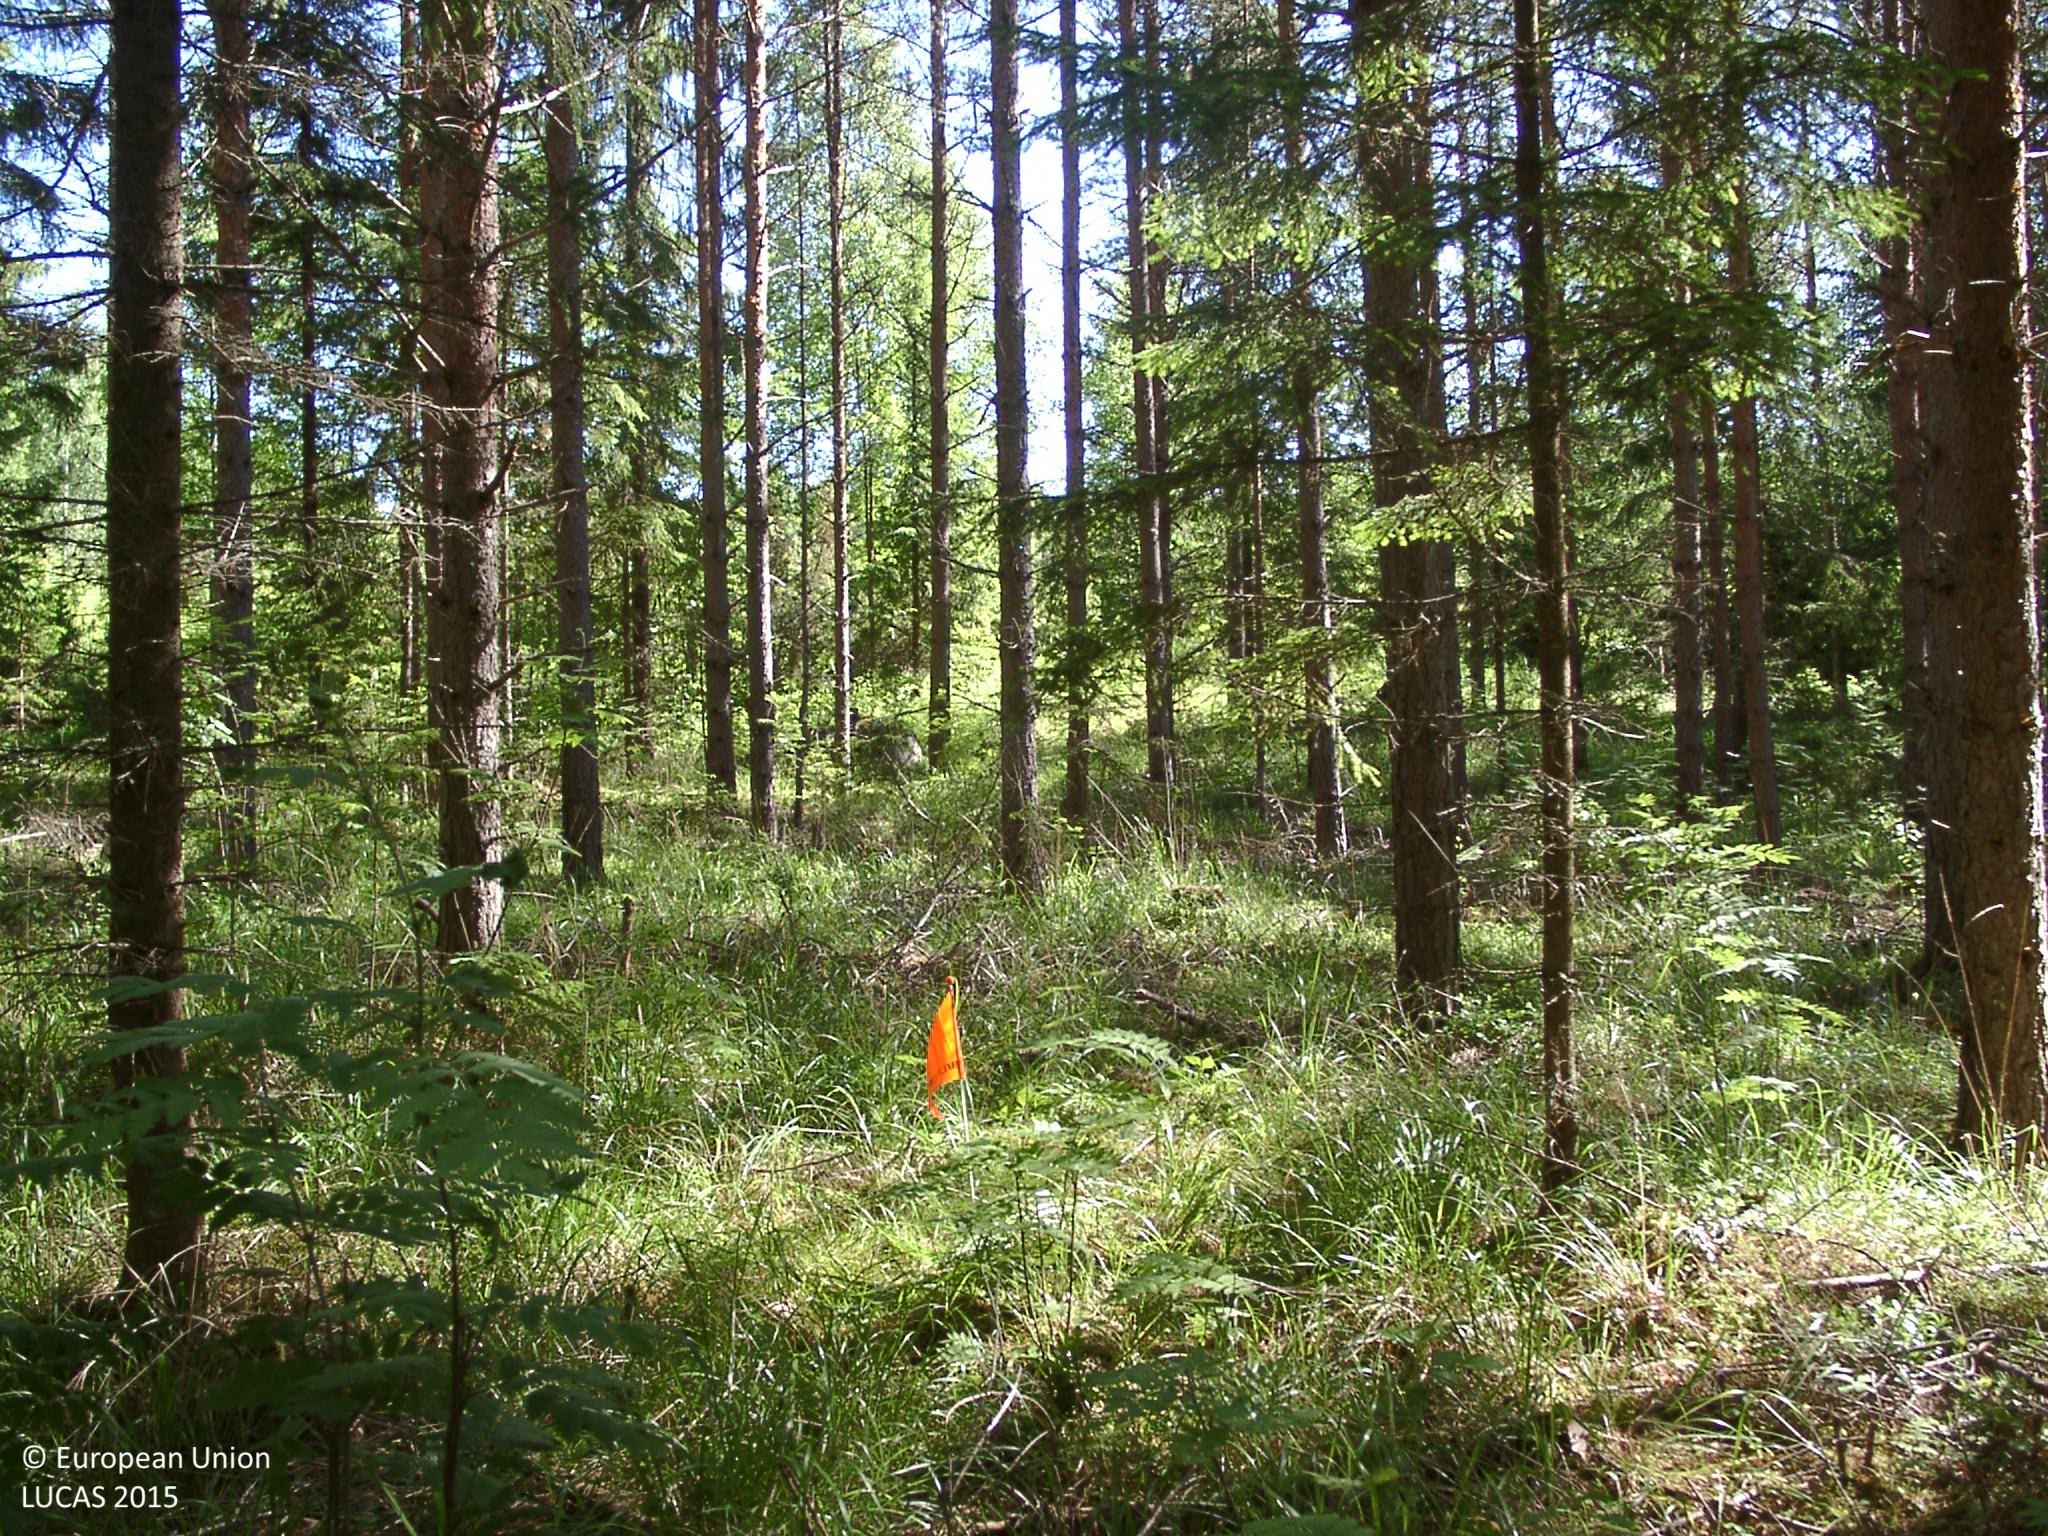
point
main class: Woodland
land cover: Other coniferous woodland
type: boreal forest
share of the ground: 50 - 75 %
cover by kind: coniferous forest trees 60 %, herbaceous plants 20 %, broadleaved forest trees 5 %, shrubs 5 %, lichens and mosses 5 %
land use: Forestry
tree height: > 5 m
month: June
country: FI
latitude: 62.1267
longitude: 25.0408
